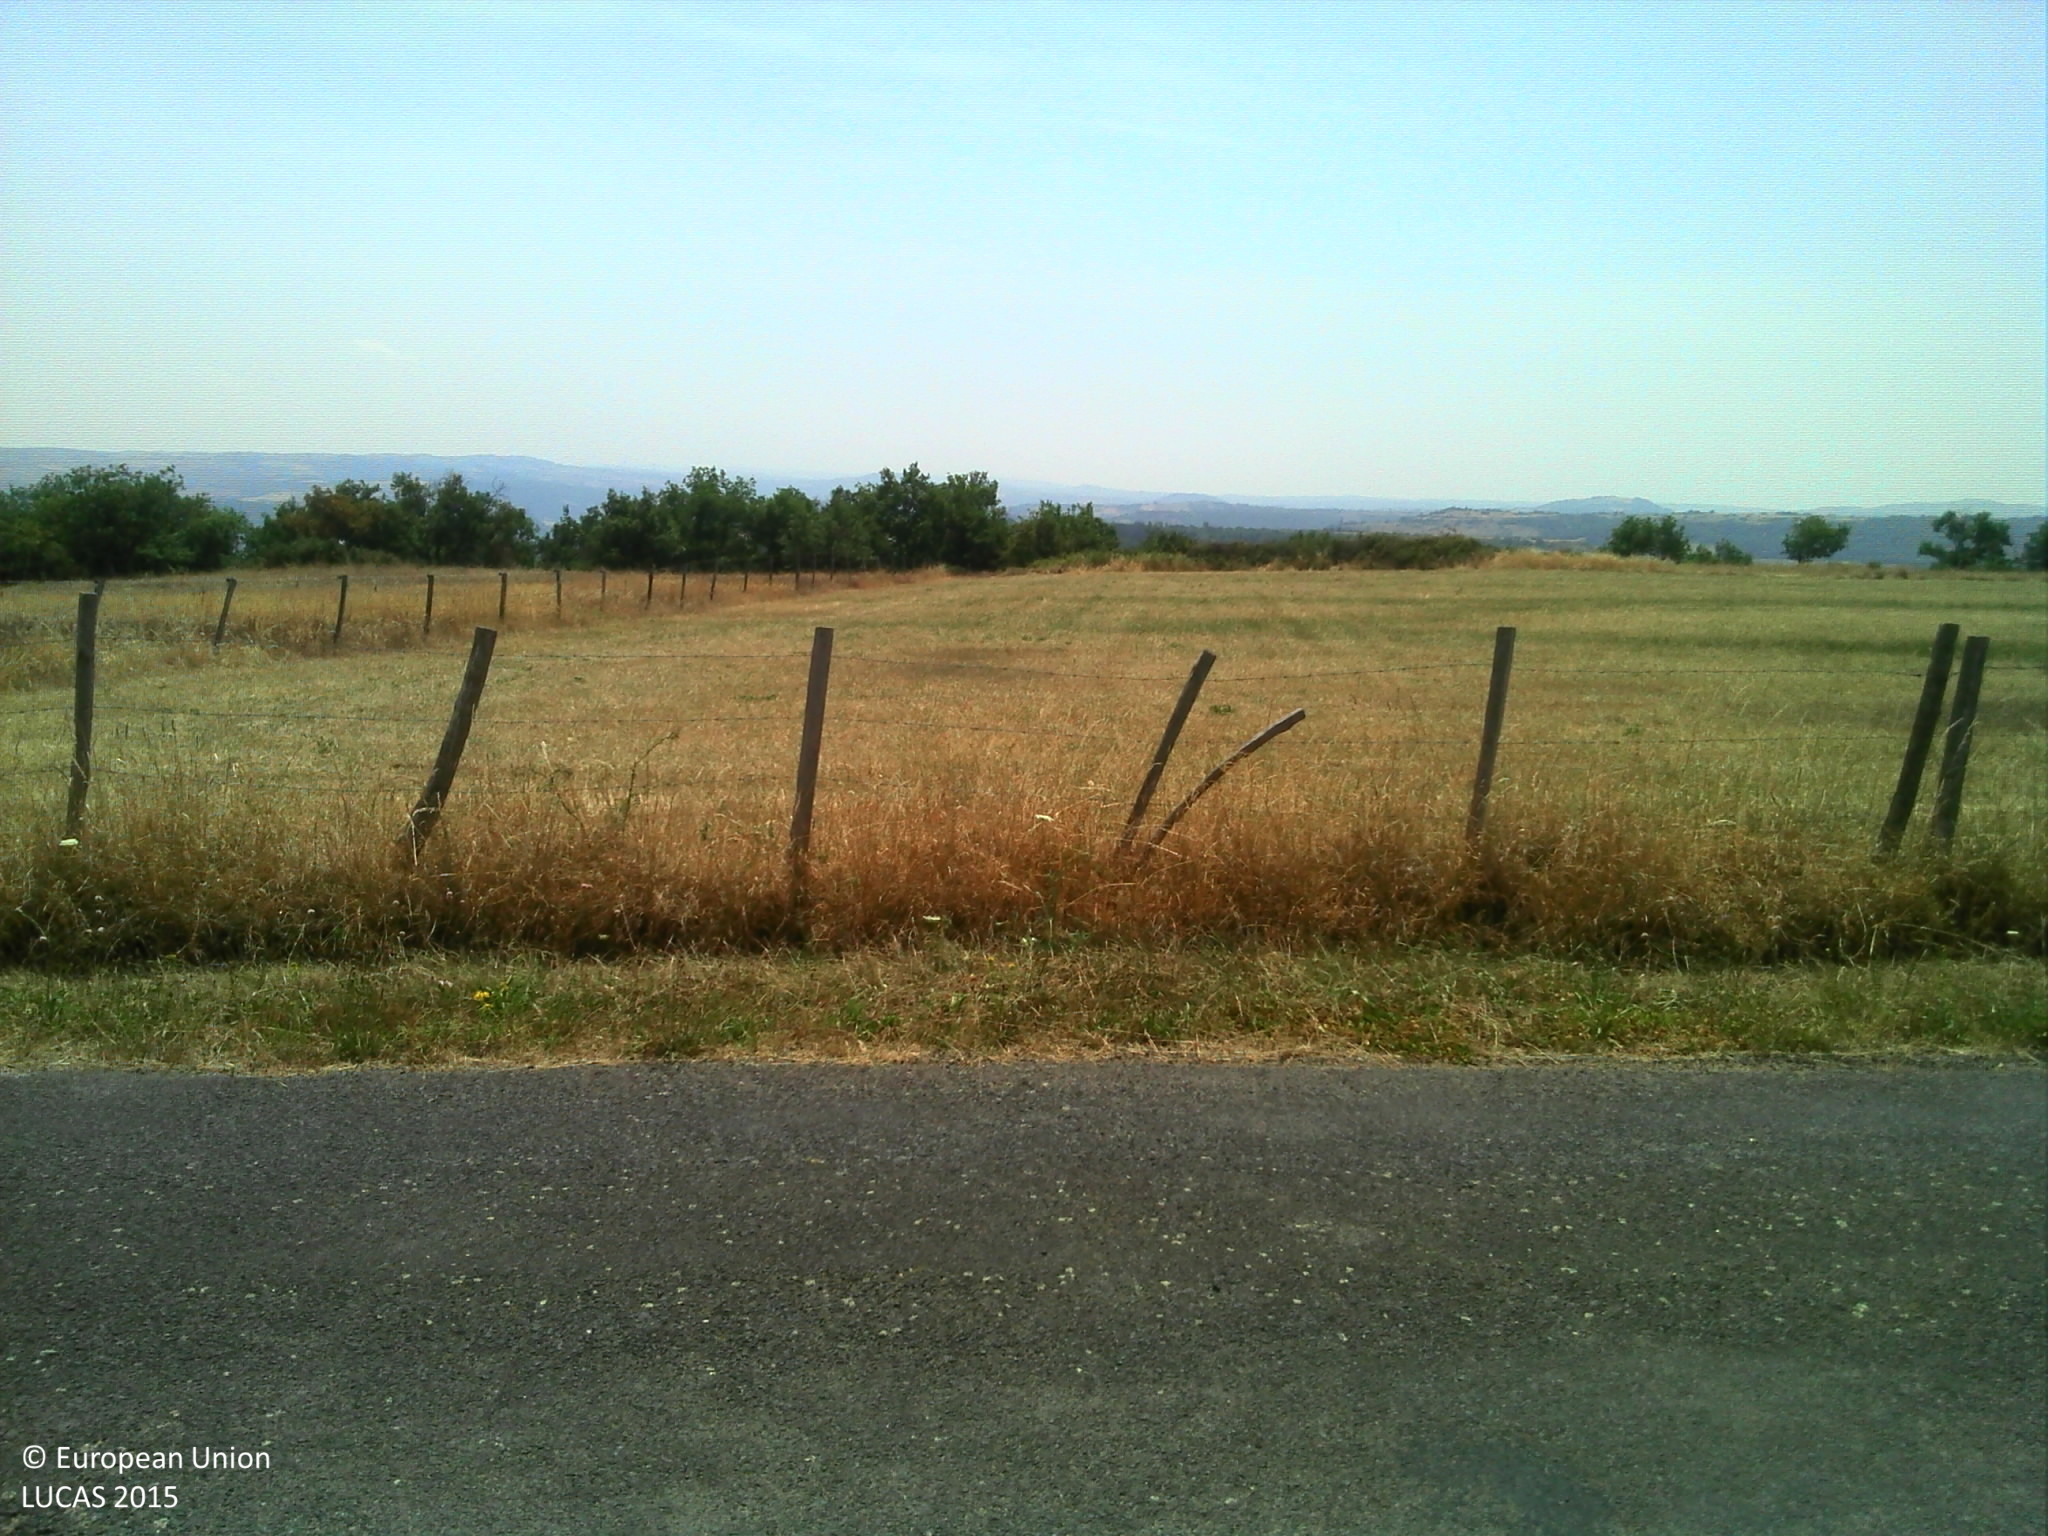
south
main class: Cropland
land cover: Rye
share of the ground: > 75 %
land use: Agriculture (excluding fallow land and kitchen gardens)
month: July
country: FR
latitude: 45.3360
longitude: 3.1489
